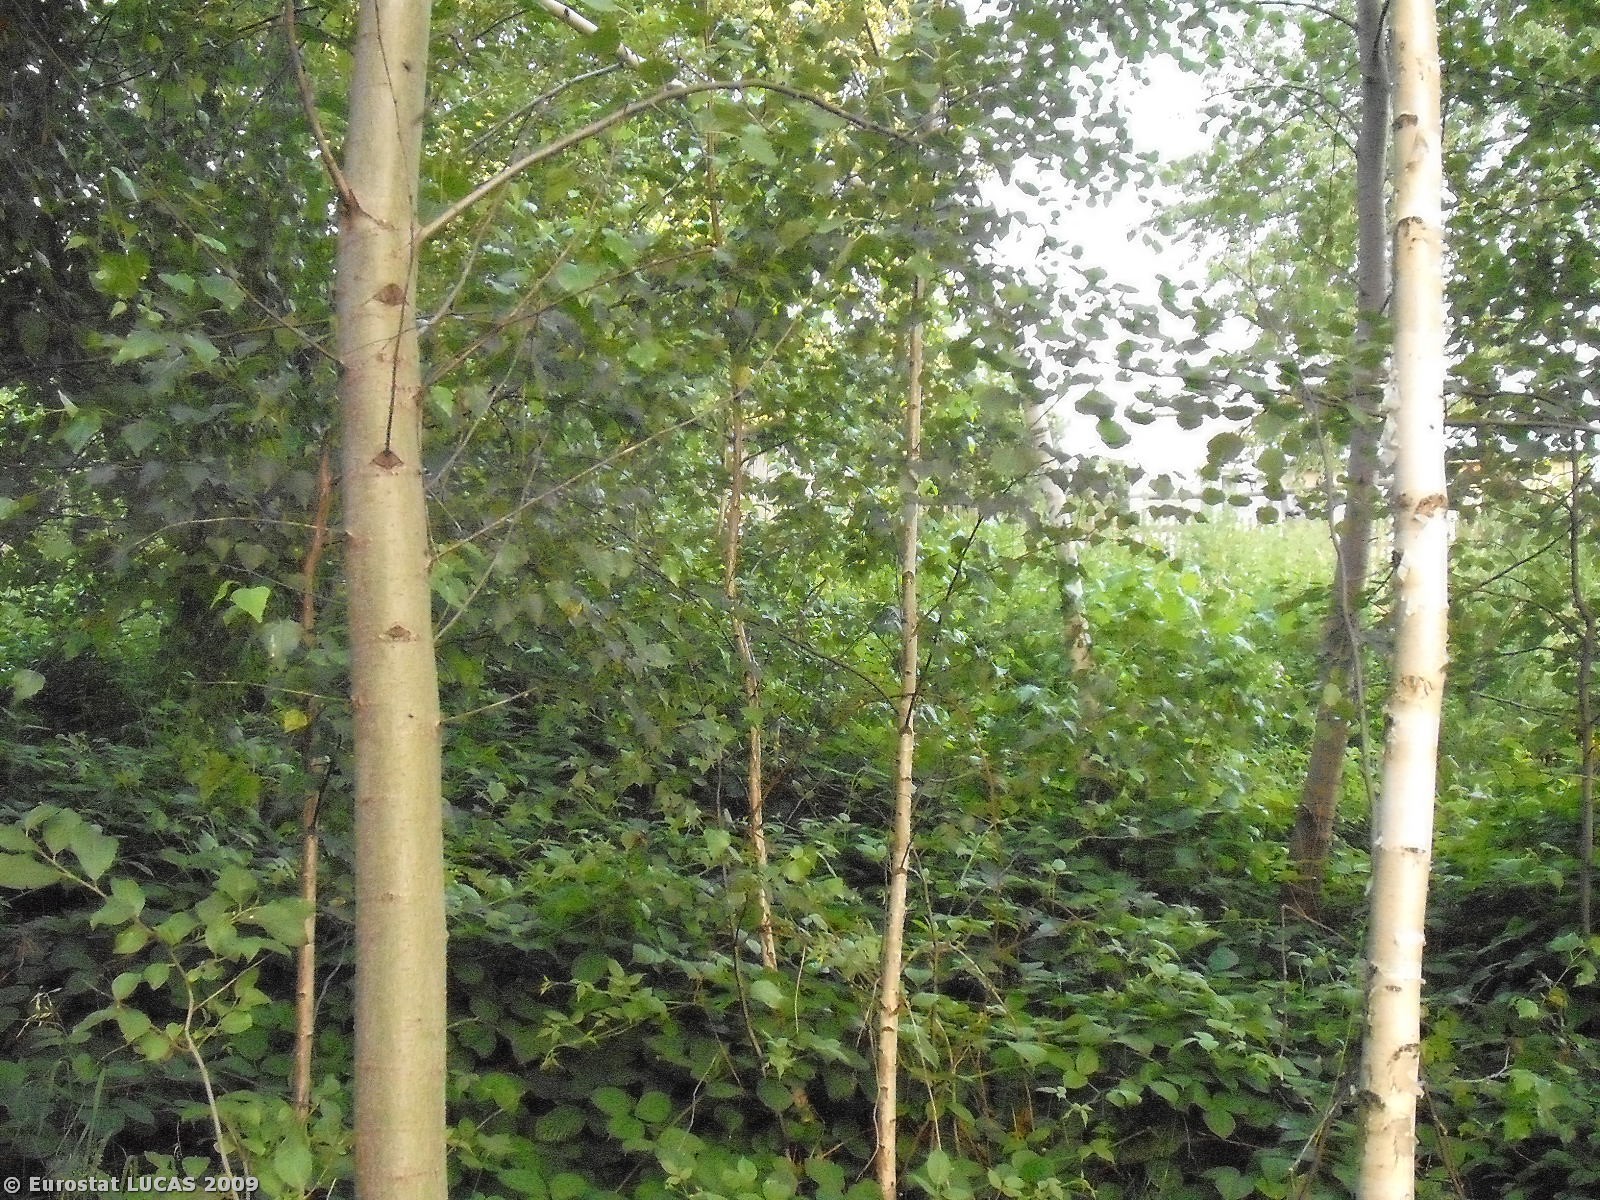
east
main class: Woodland
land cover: Broadleaved woodland
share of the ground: > 75 %
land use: Unused
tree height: > 5 m
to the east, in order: Broadleaved woodland; Fences; Artificial constructions in urban areas; Grassland with sparse tree/shrub cover
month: July
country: PL
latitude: 50.9943
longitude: 20.7991
